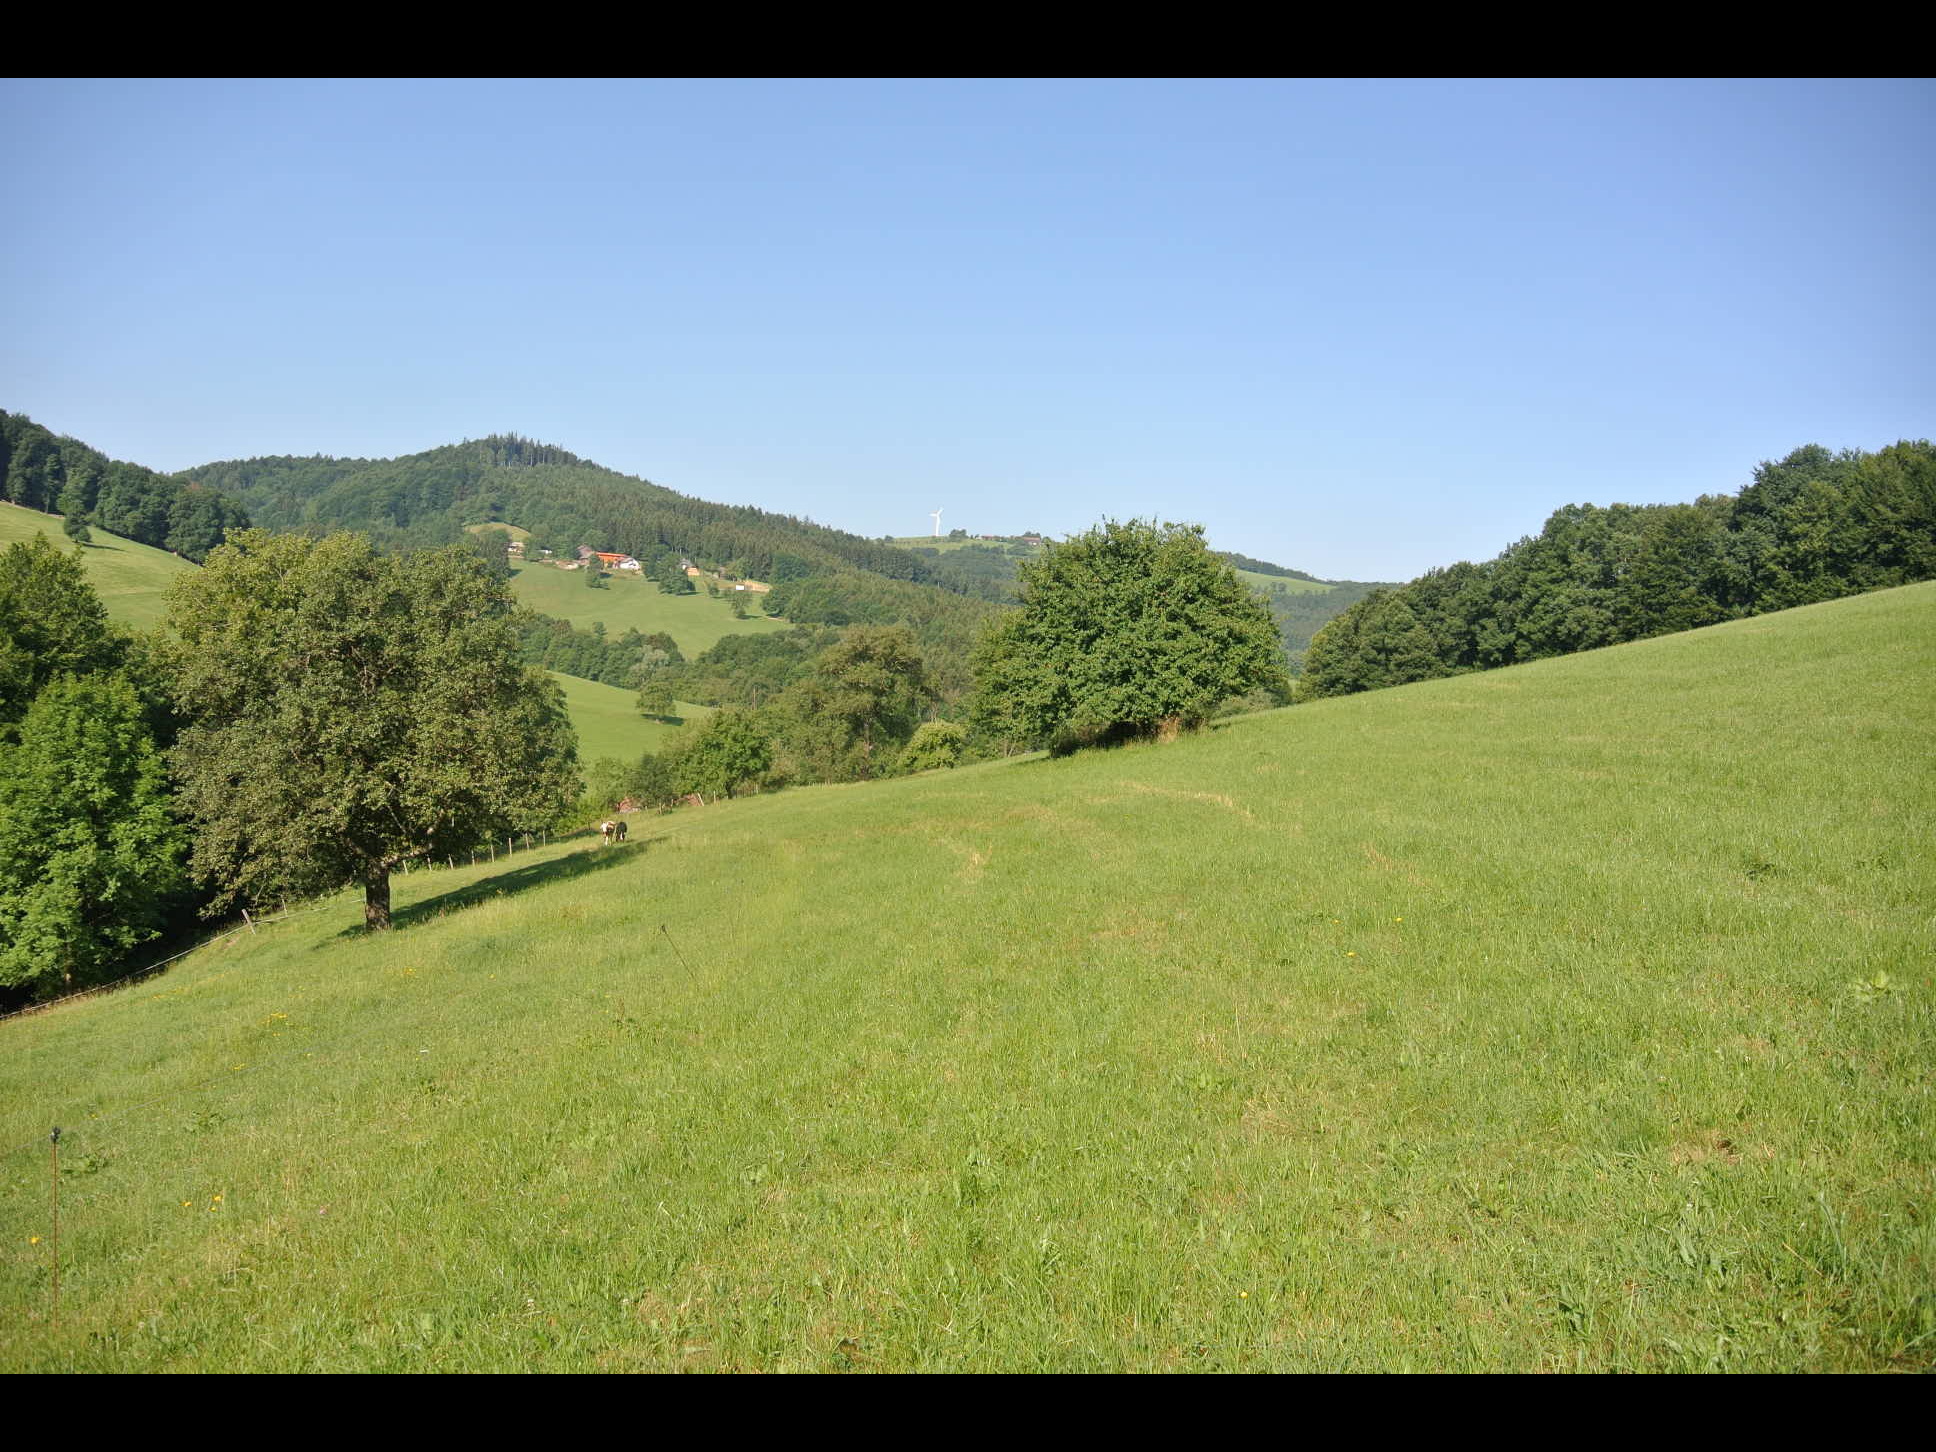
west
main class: Grassland
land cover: Grassland without tree/shrub cover
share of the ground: > 75 %
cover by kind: herbaceous plants 100 %
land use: Agriculture (excluding fallow land and kitchen gardens)
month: July
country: AT
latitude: 48.0895
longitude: 15.7894
